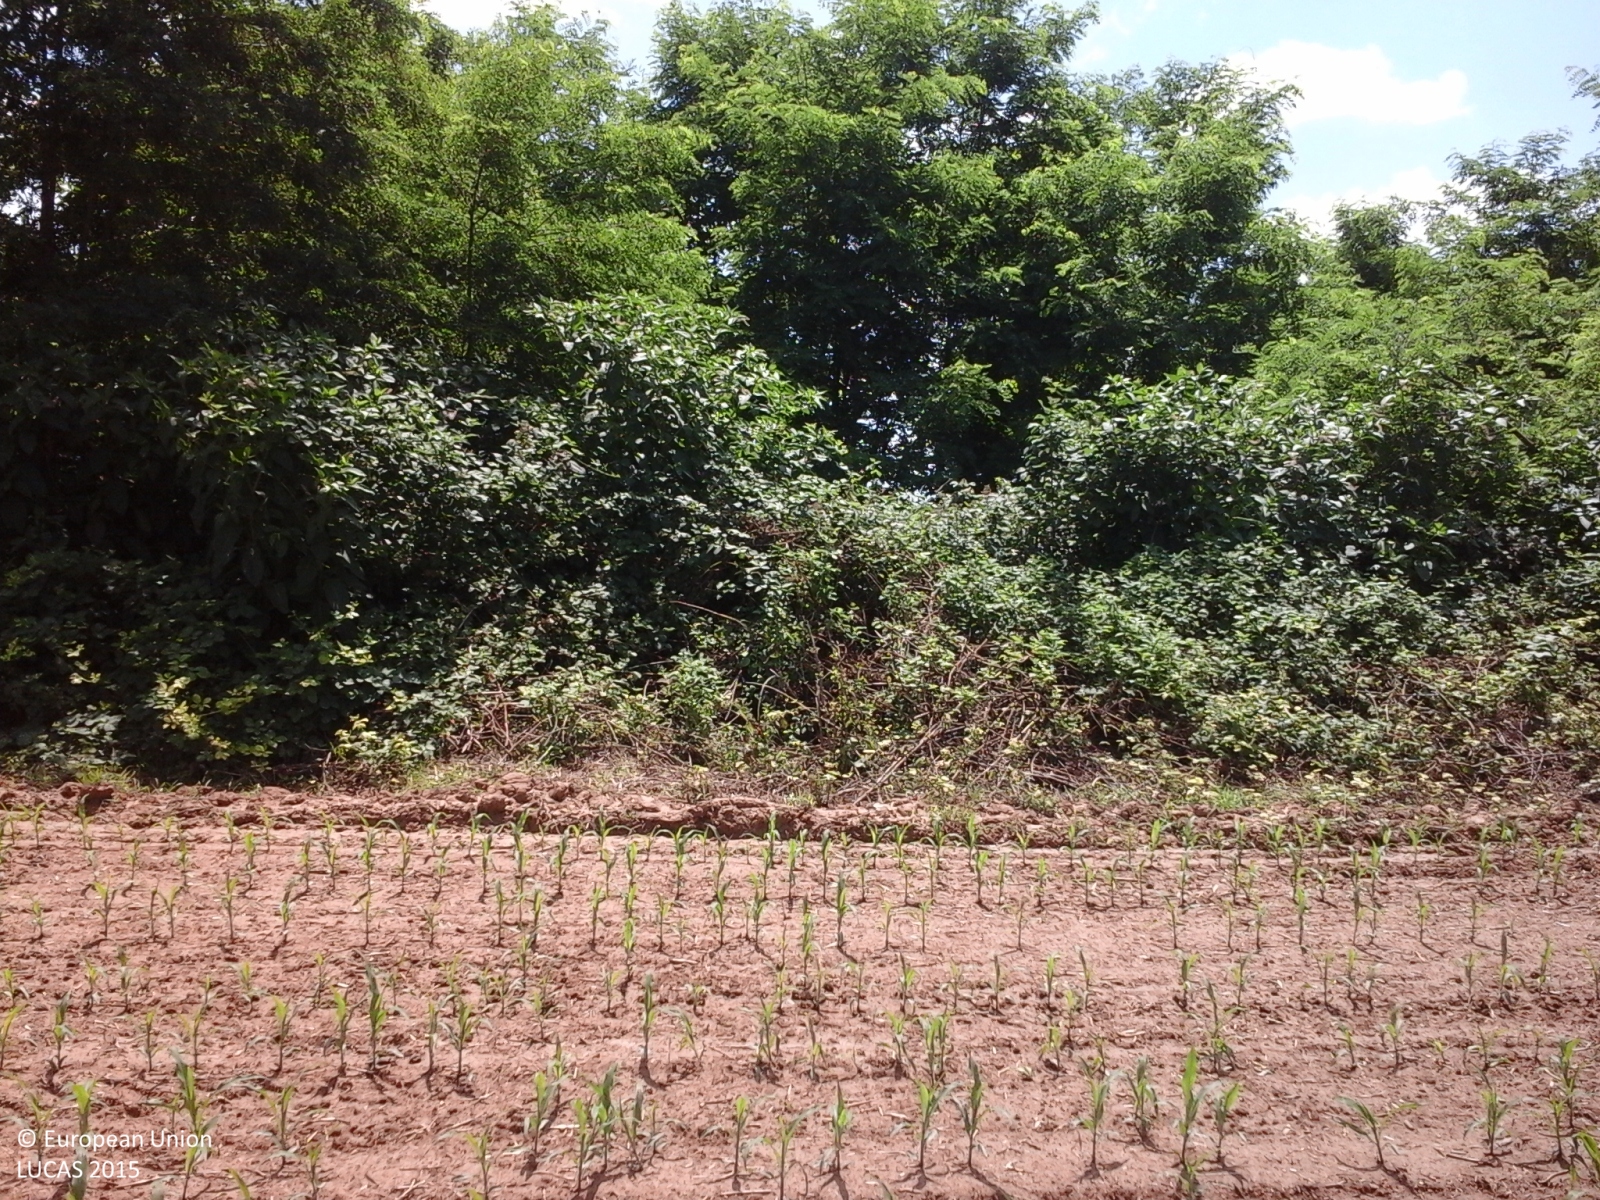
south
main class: Cropland
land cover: Maize
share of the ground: < 10 %
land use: Agriculture (excluding fallow land and kitchen gardens)
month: June
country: IT
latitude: 44.8867
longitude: 7.8137
